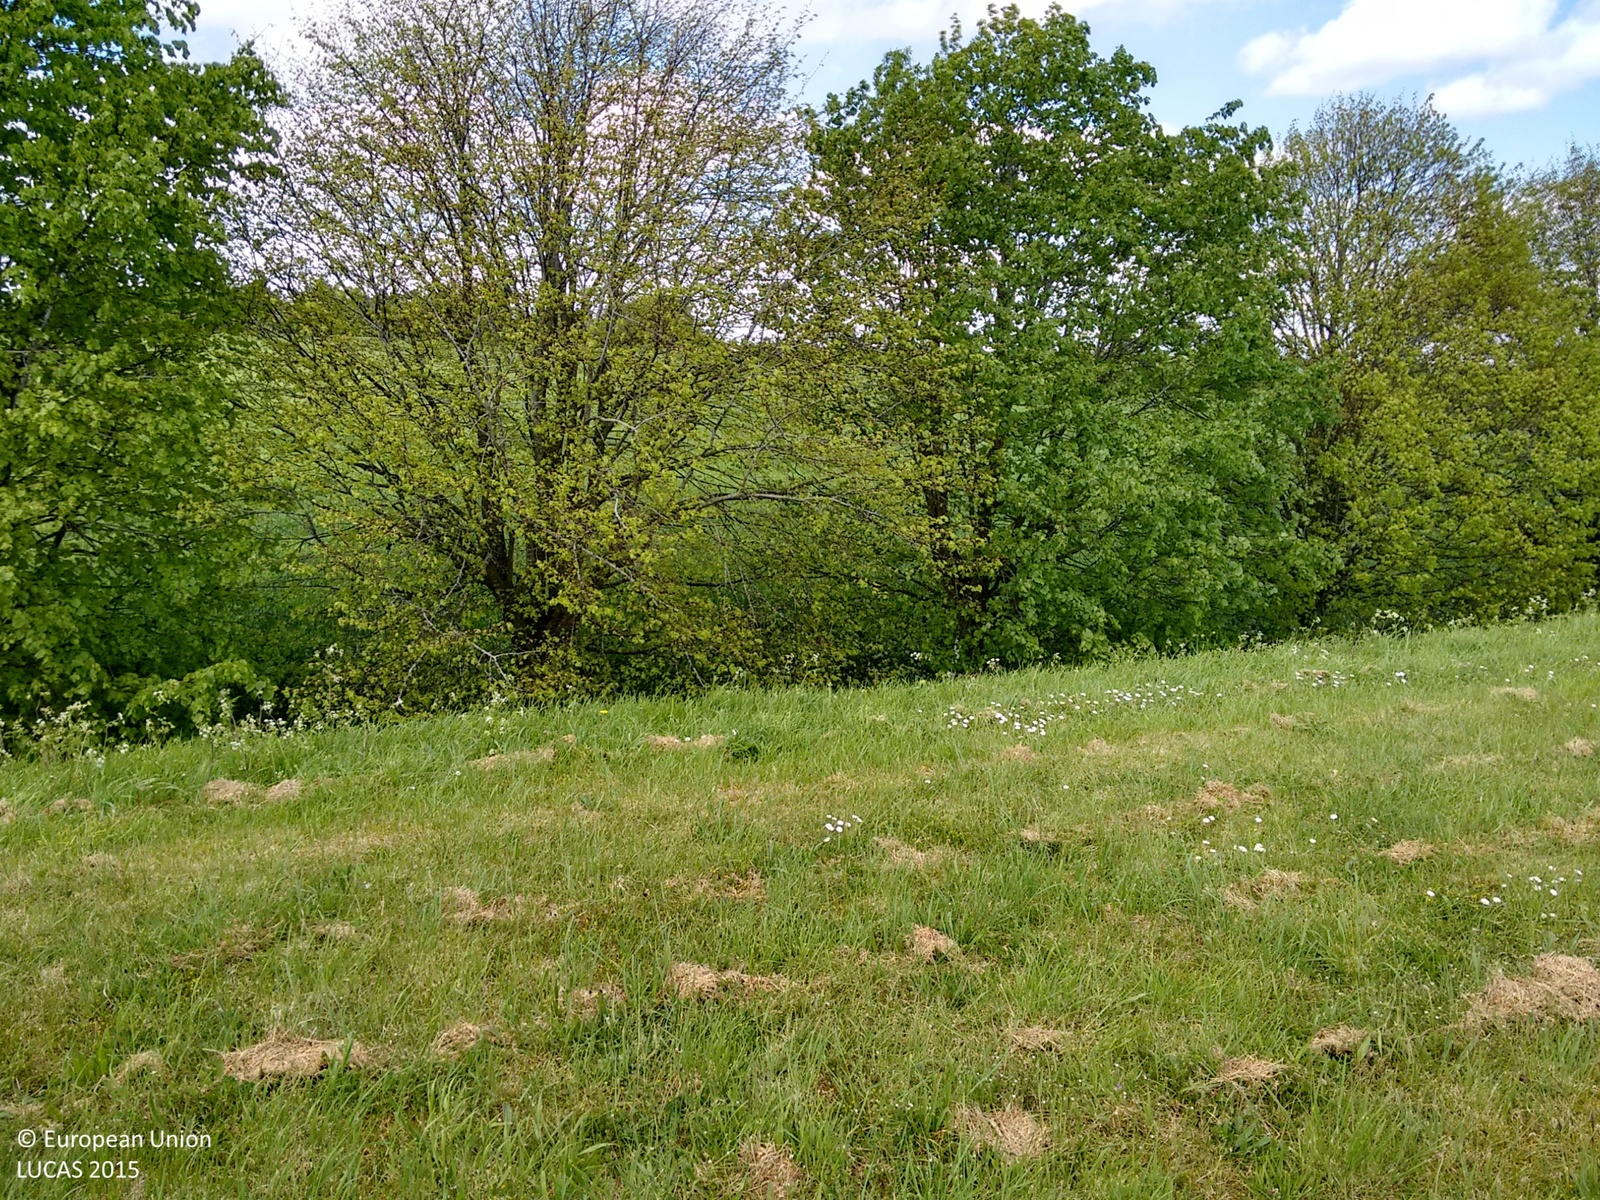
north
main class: Grassland
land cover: Grassland without tree/shrub cover
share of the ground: > 75 %
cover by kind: herbaceous plants 100 %
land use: Semi-natural and natural areas not in use
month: May
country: GB
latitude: 51.2867
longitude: -1.1589
